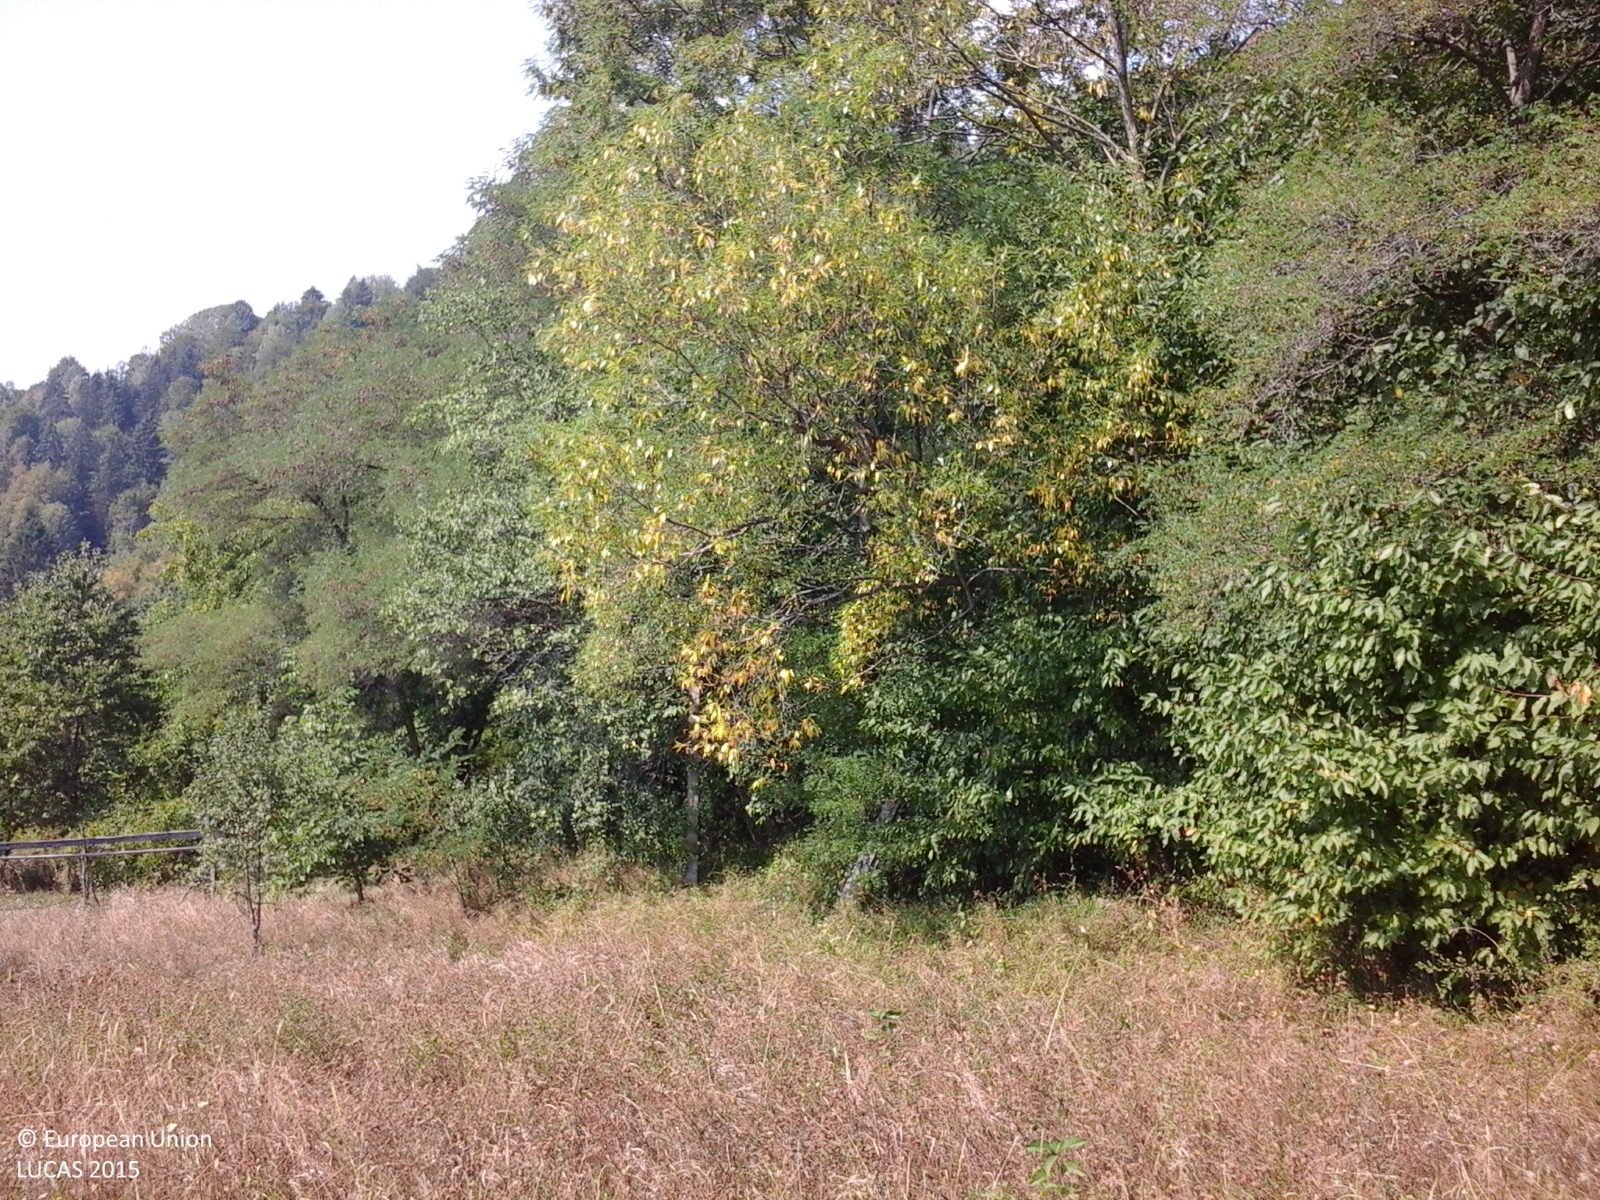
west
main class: Grassland
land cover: Grassland without tree/shrub cover
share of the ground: > 75 %
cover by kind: herbaceous plants 100 %
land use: Agriculture (excluding fallow land and kitchen gardens)
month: September
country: RO
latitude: 47.6691
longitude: 24.5726
